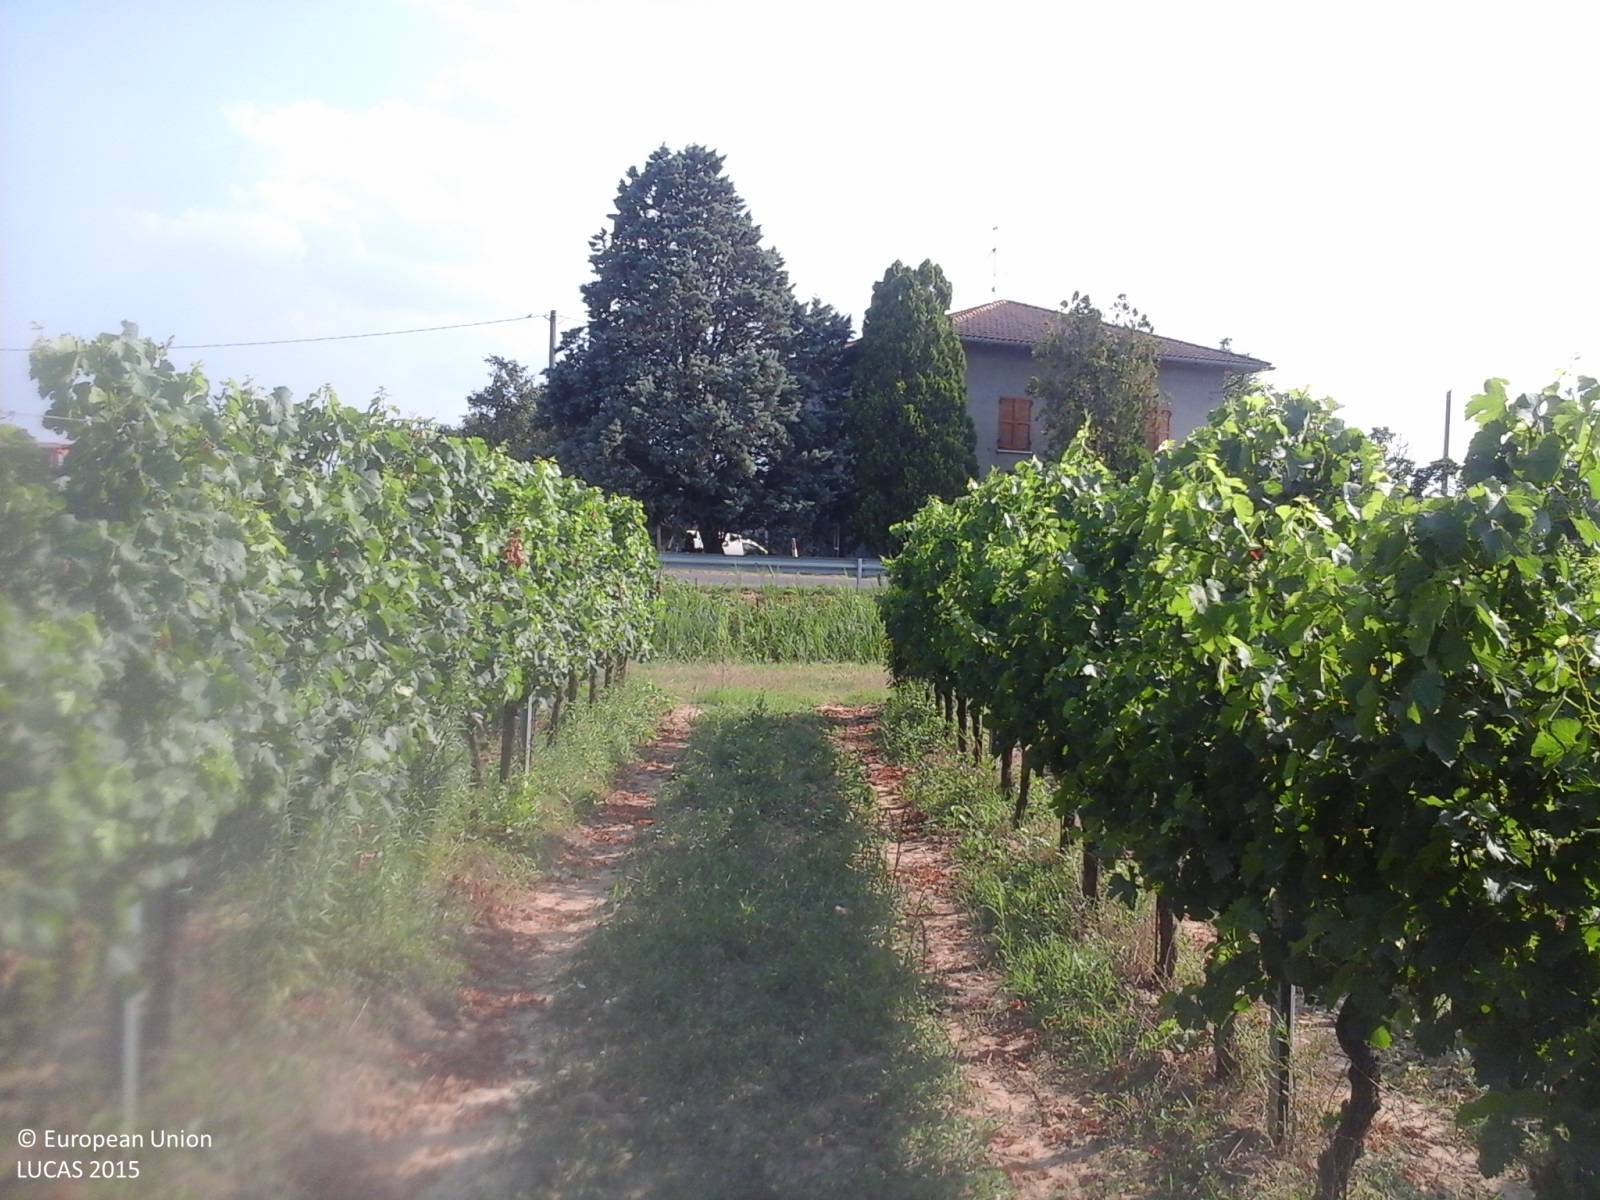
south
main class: Cropland
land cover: Vineyards
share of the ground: 25 - 50 %
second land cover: Grassland without tree/shrub cover
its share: 25 - 50 %
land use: Agriculture (excluding fallow land and kitchen gardens)
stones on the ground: 10 - 25 %
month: July
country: IT
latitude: 43.1424
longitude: 11.8756
